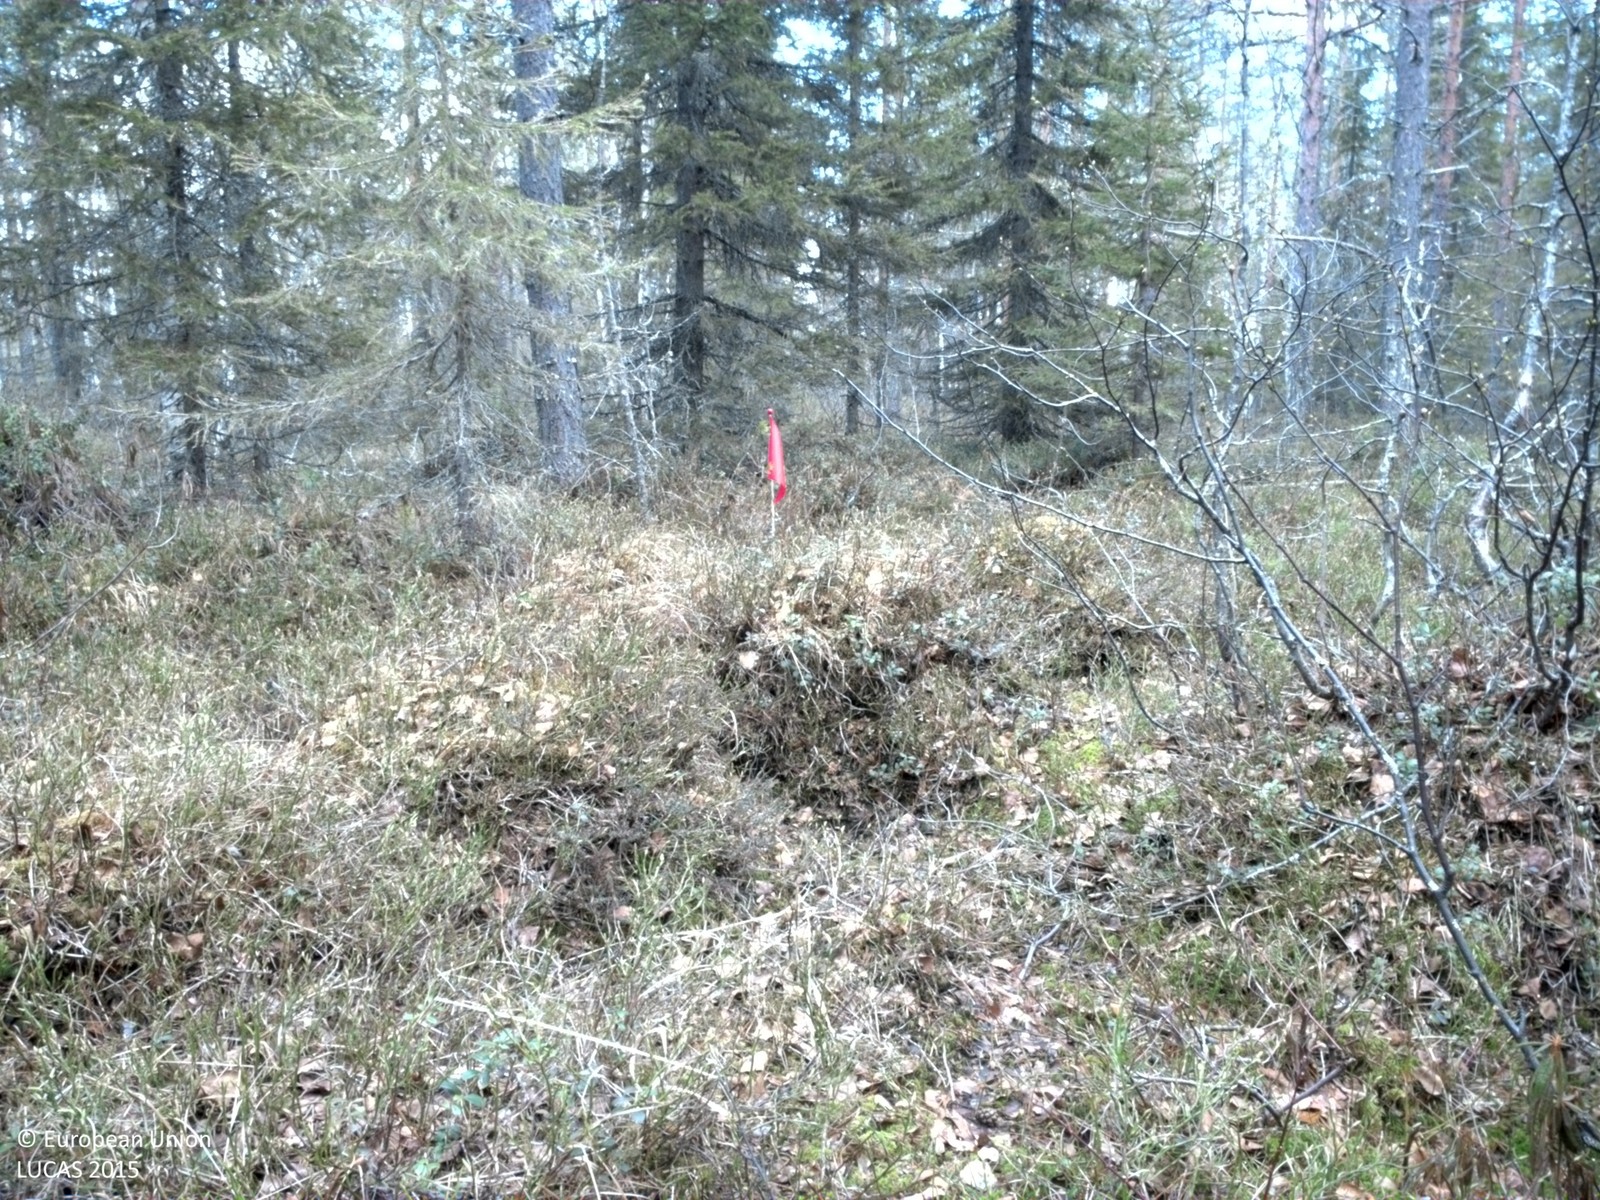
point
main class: Woodland
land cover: Pine dominated mixed woodland
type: boreal forest
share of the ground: > 75 %
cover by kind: coniferous forest trees 60 %, broadleaved forest trees 20 %, shrubs 20 %
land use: Forestry
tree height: > 5 m
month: May
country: SE
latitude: 66.0987
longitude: 23.2800
